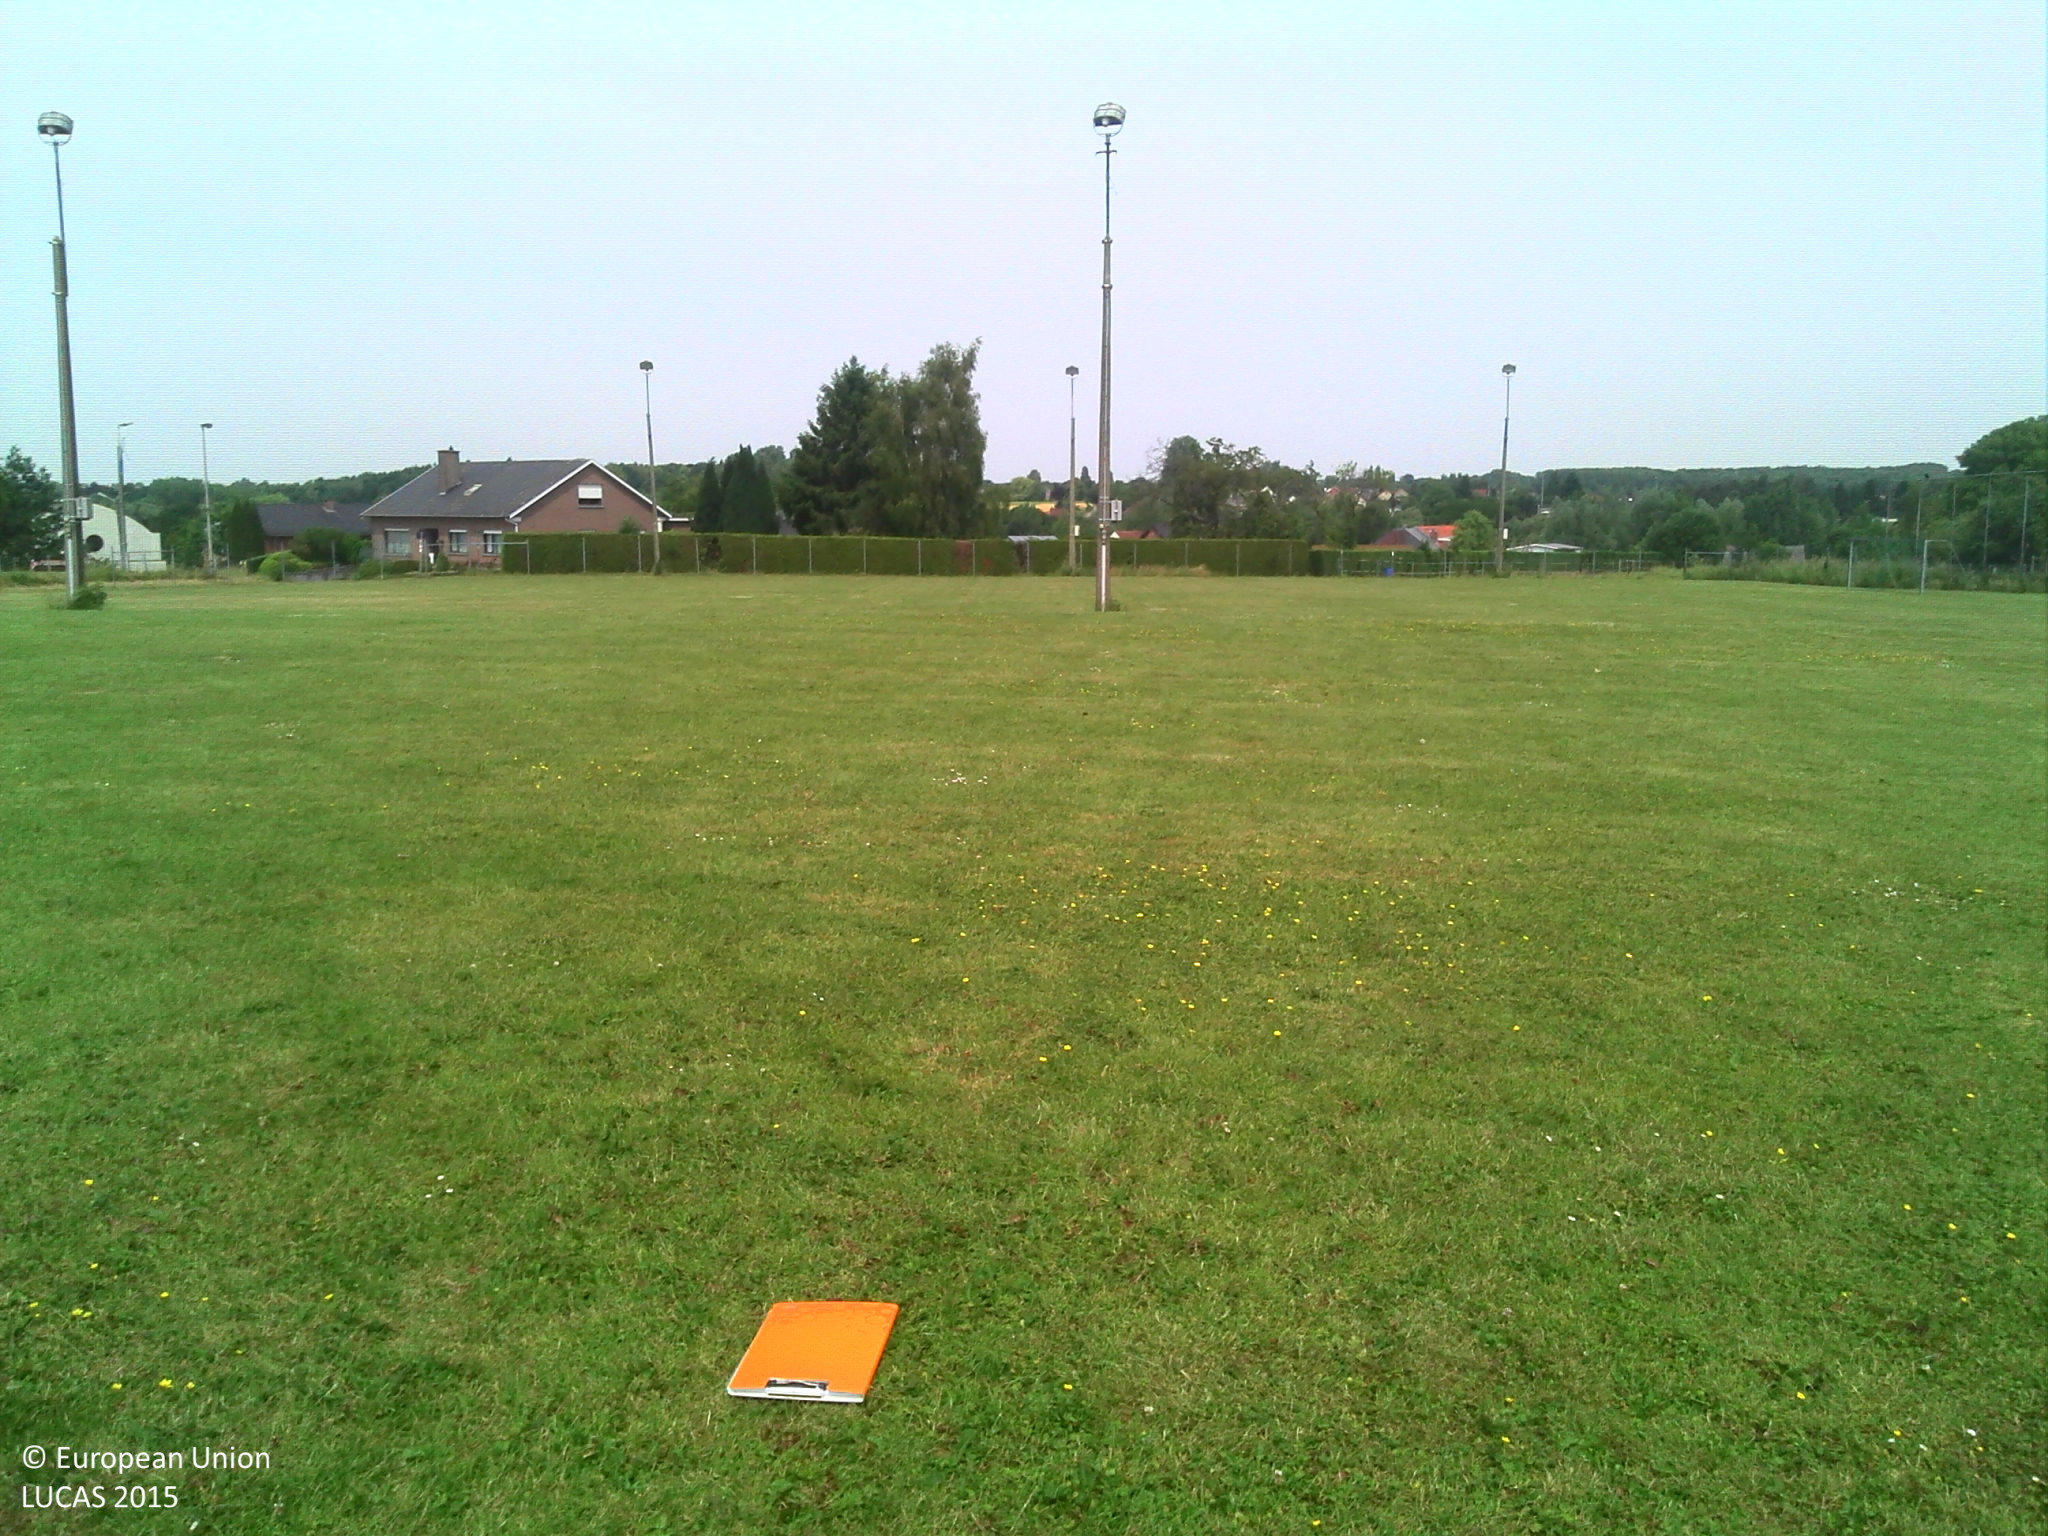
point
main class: Grassland
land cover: Grassland without tree/shrub cover
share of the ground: > 75 %
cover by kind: herbaceous plants 95 %, shrubs 5 %
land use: Sport
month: June
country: BE
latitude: 50.8293
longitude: 4.5583
